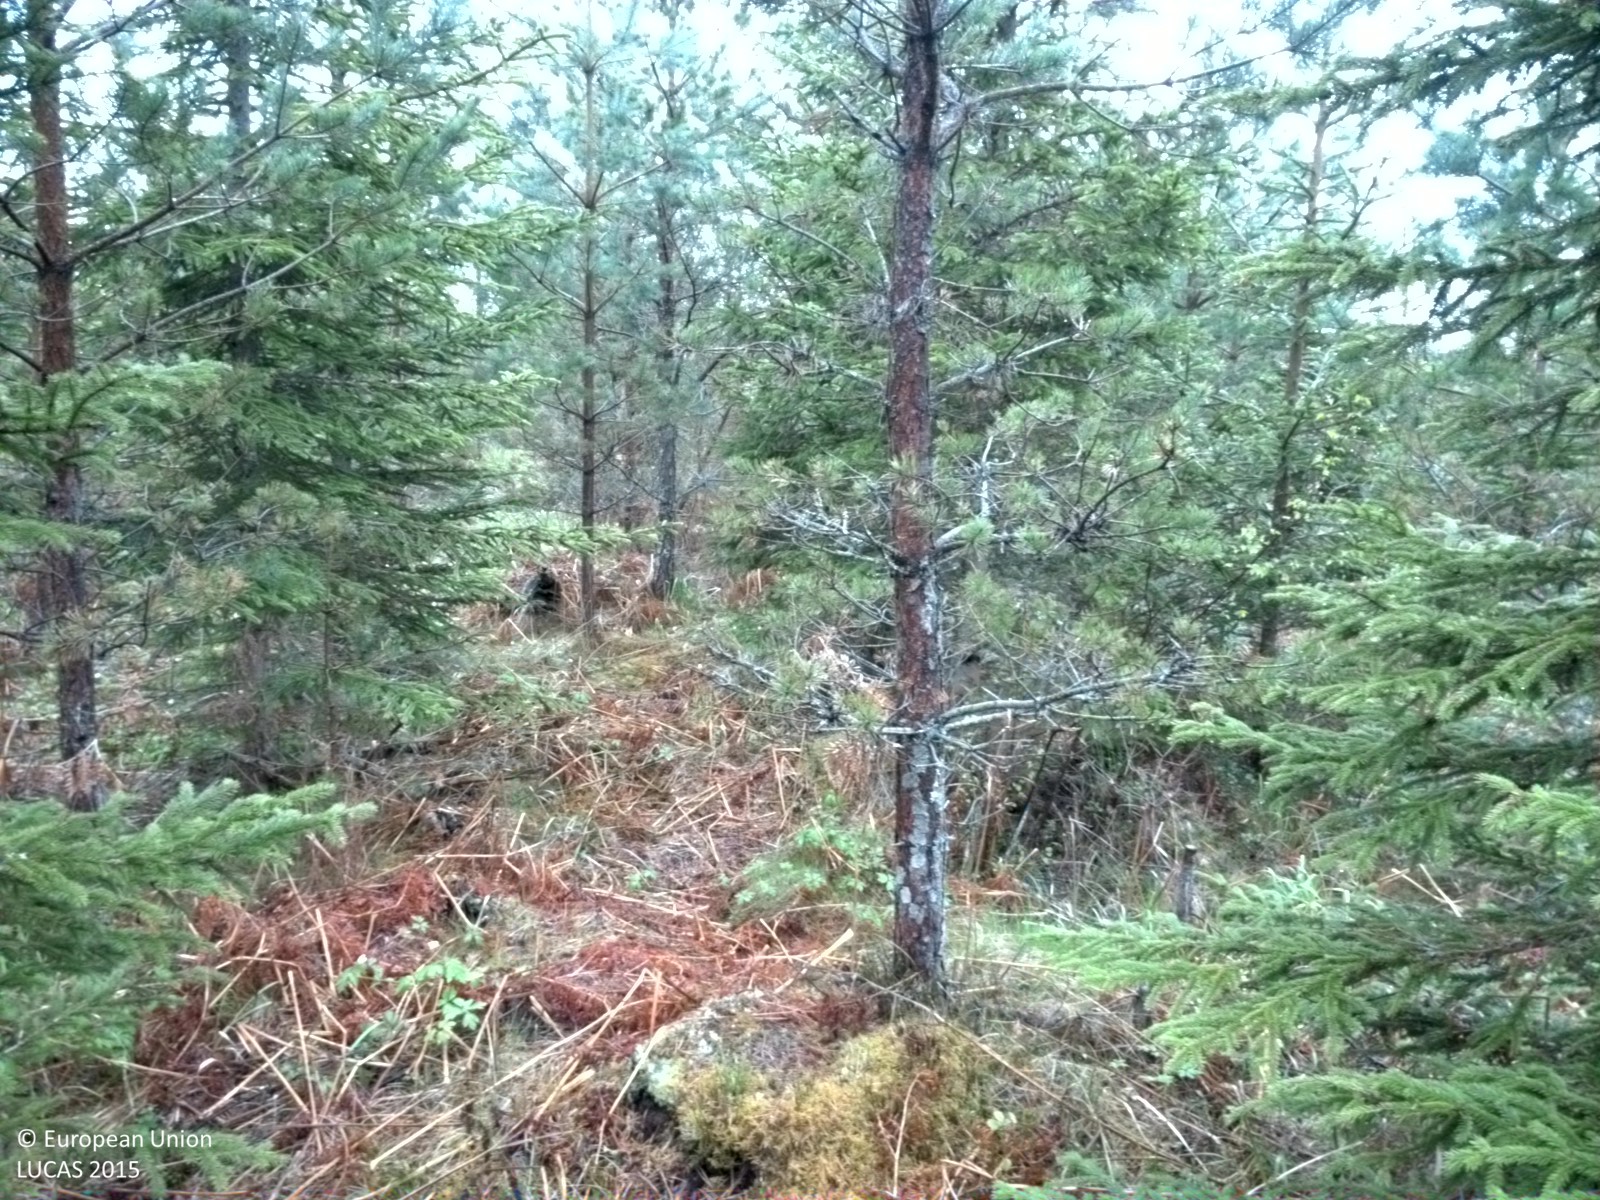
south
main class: Woodland
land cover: Spruce dominated coniferous woodland
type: boreal forest
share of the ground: > 75 %
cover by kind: coniferous forest trees 75 %, broadleaved forest trees 10 %, herbaceous plants 10 %, shrubs 5 %
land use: Forestry
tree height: > 5 m
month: May
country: SE
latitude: 60.2035
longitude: 18.0588
